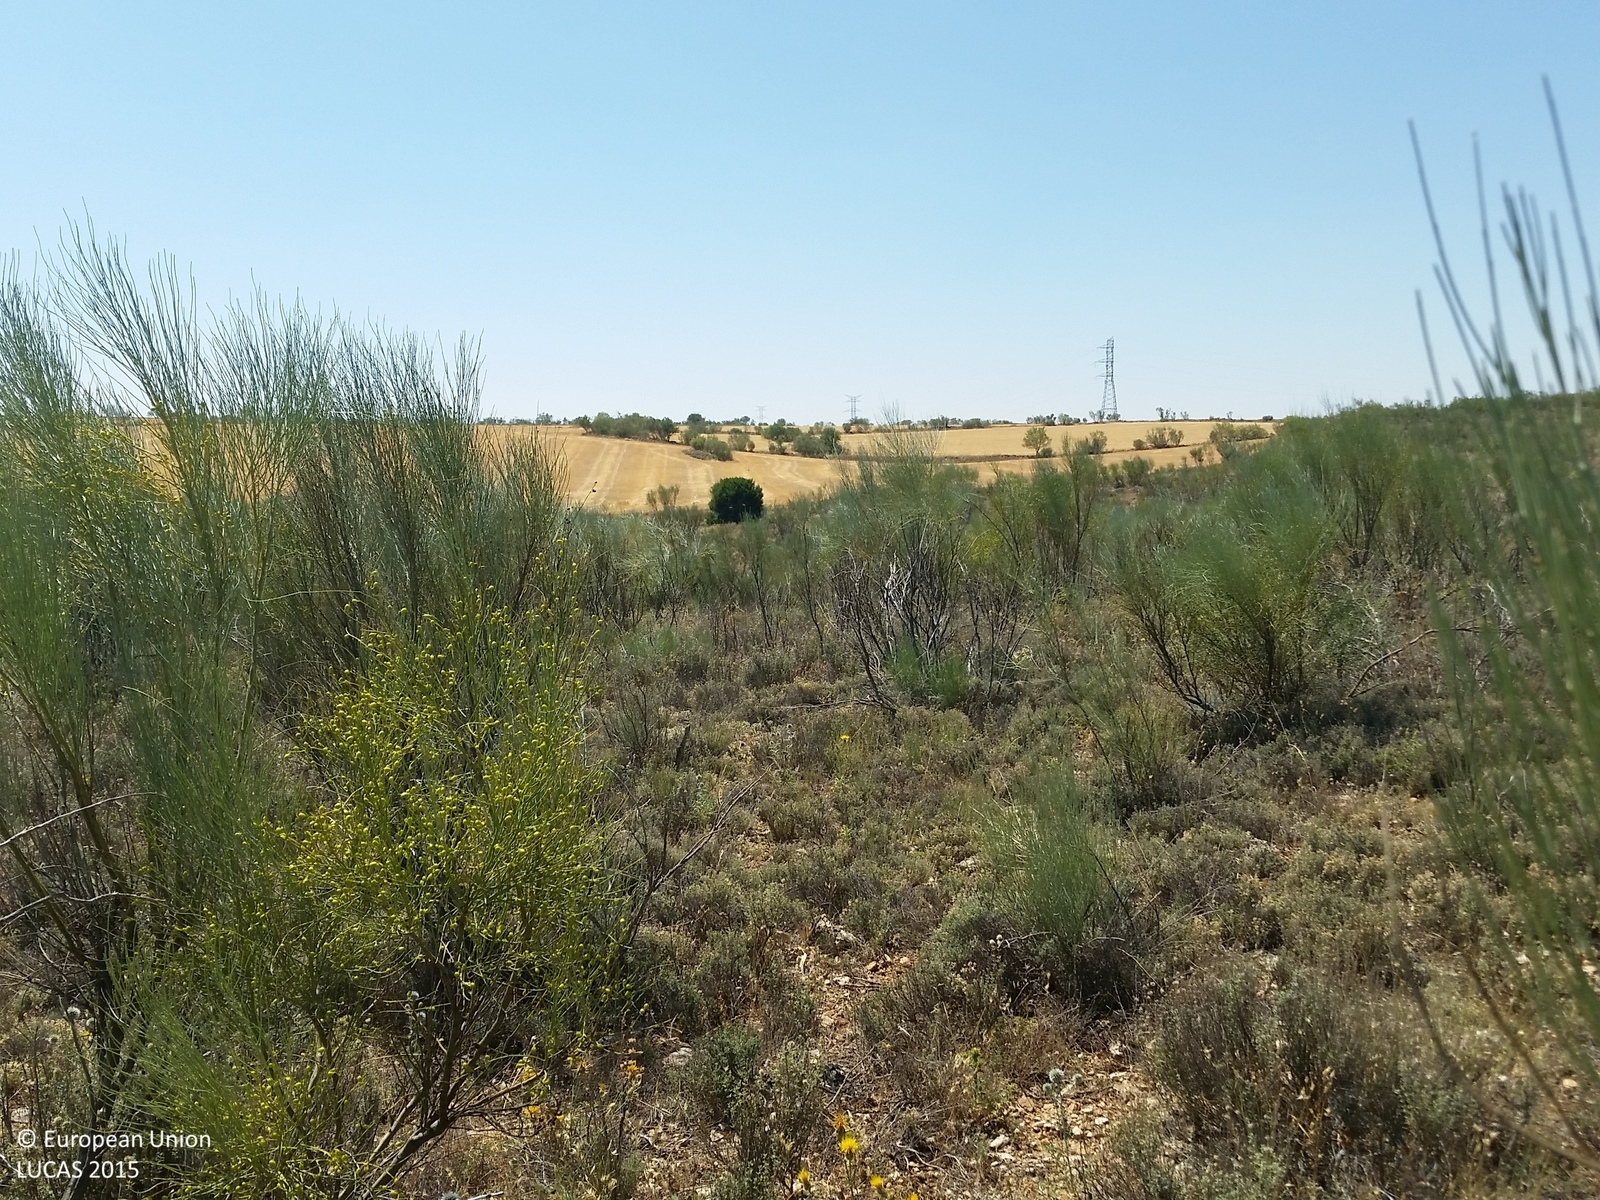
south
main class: Shrubland
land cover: Shrubland without tree cover
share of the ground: > 75 %
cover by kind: shrubs 75 %, consolidated bare surface 15 %, herbaceous plants 10 %
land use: Semi-natural and natural areas not in use
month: July
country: ES
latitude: 38.9759
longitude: -2.5994
